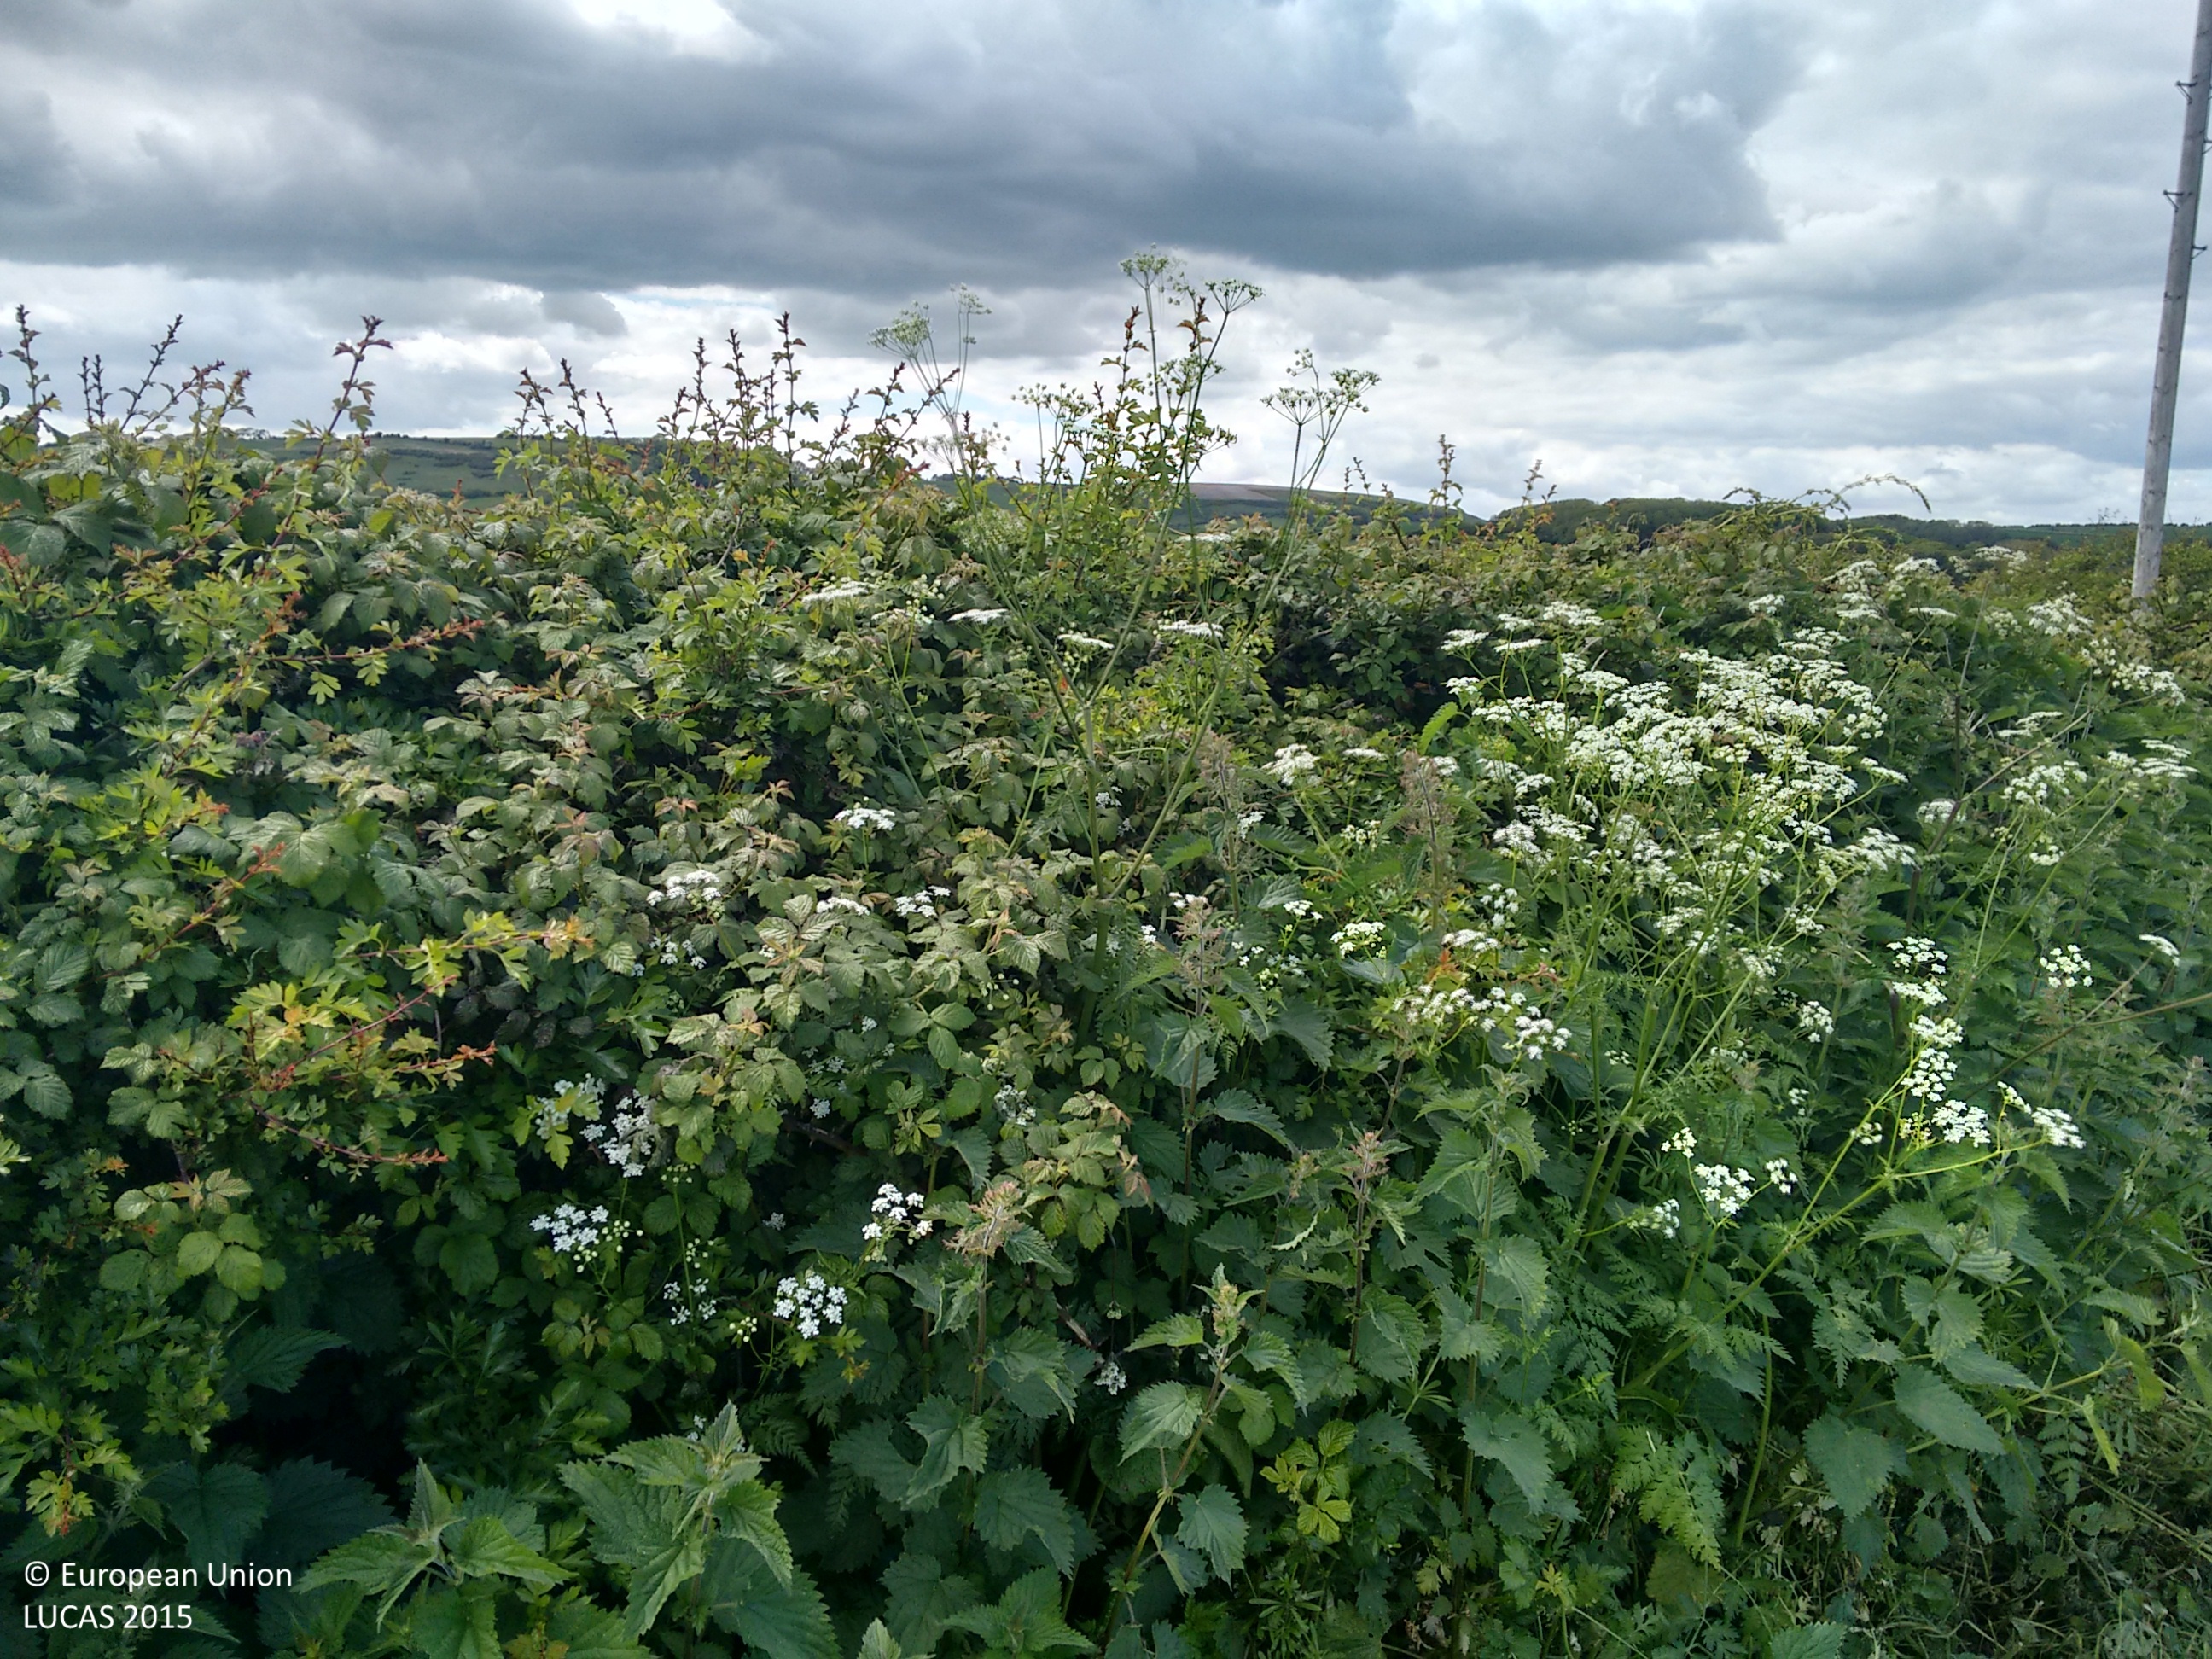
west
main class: Grassland
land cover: Grassland without tree/shrub cover
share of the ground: > 75 %
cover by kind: herbaceous plants 75 %, unconsolidated bare surface 25 %
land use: Agriculture (excluding fallow land and kitchen gardens)
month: May
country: GB
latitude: 50.6562
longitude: -1.2934
